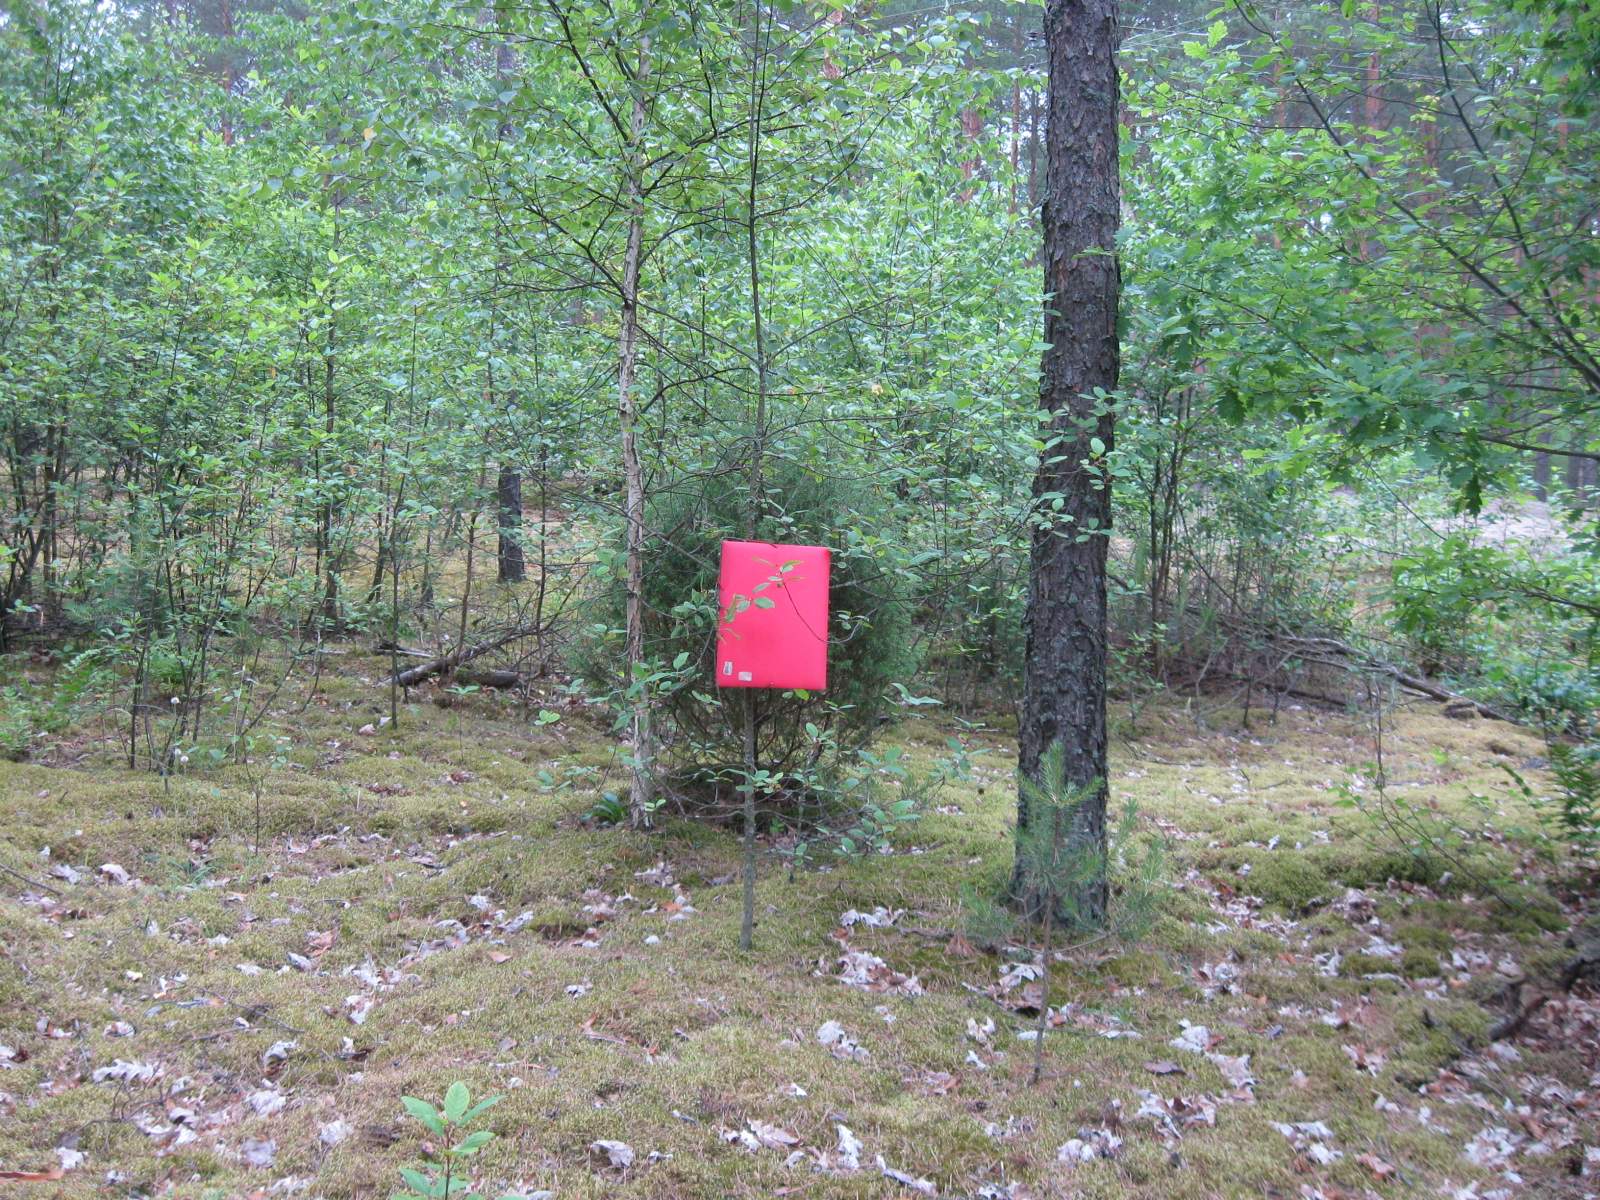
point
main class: Woodland
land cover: Pine dominated mixed woodland
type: hemiboreal forest and nemoral coniferous forest and mixed broadleaved-coniferous forest
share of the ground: > 75 %
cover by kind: coniferous forest trees 50 %, broadleaved forest trees 30 %, lichens and mosses 20 %
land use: Forestry
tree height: > 5 m
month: July
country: LT
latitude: 54.1037
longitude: 24.2761
